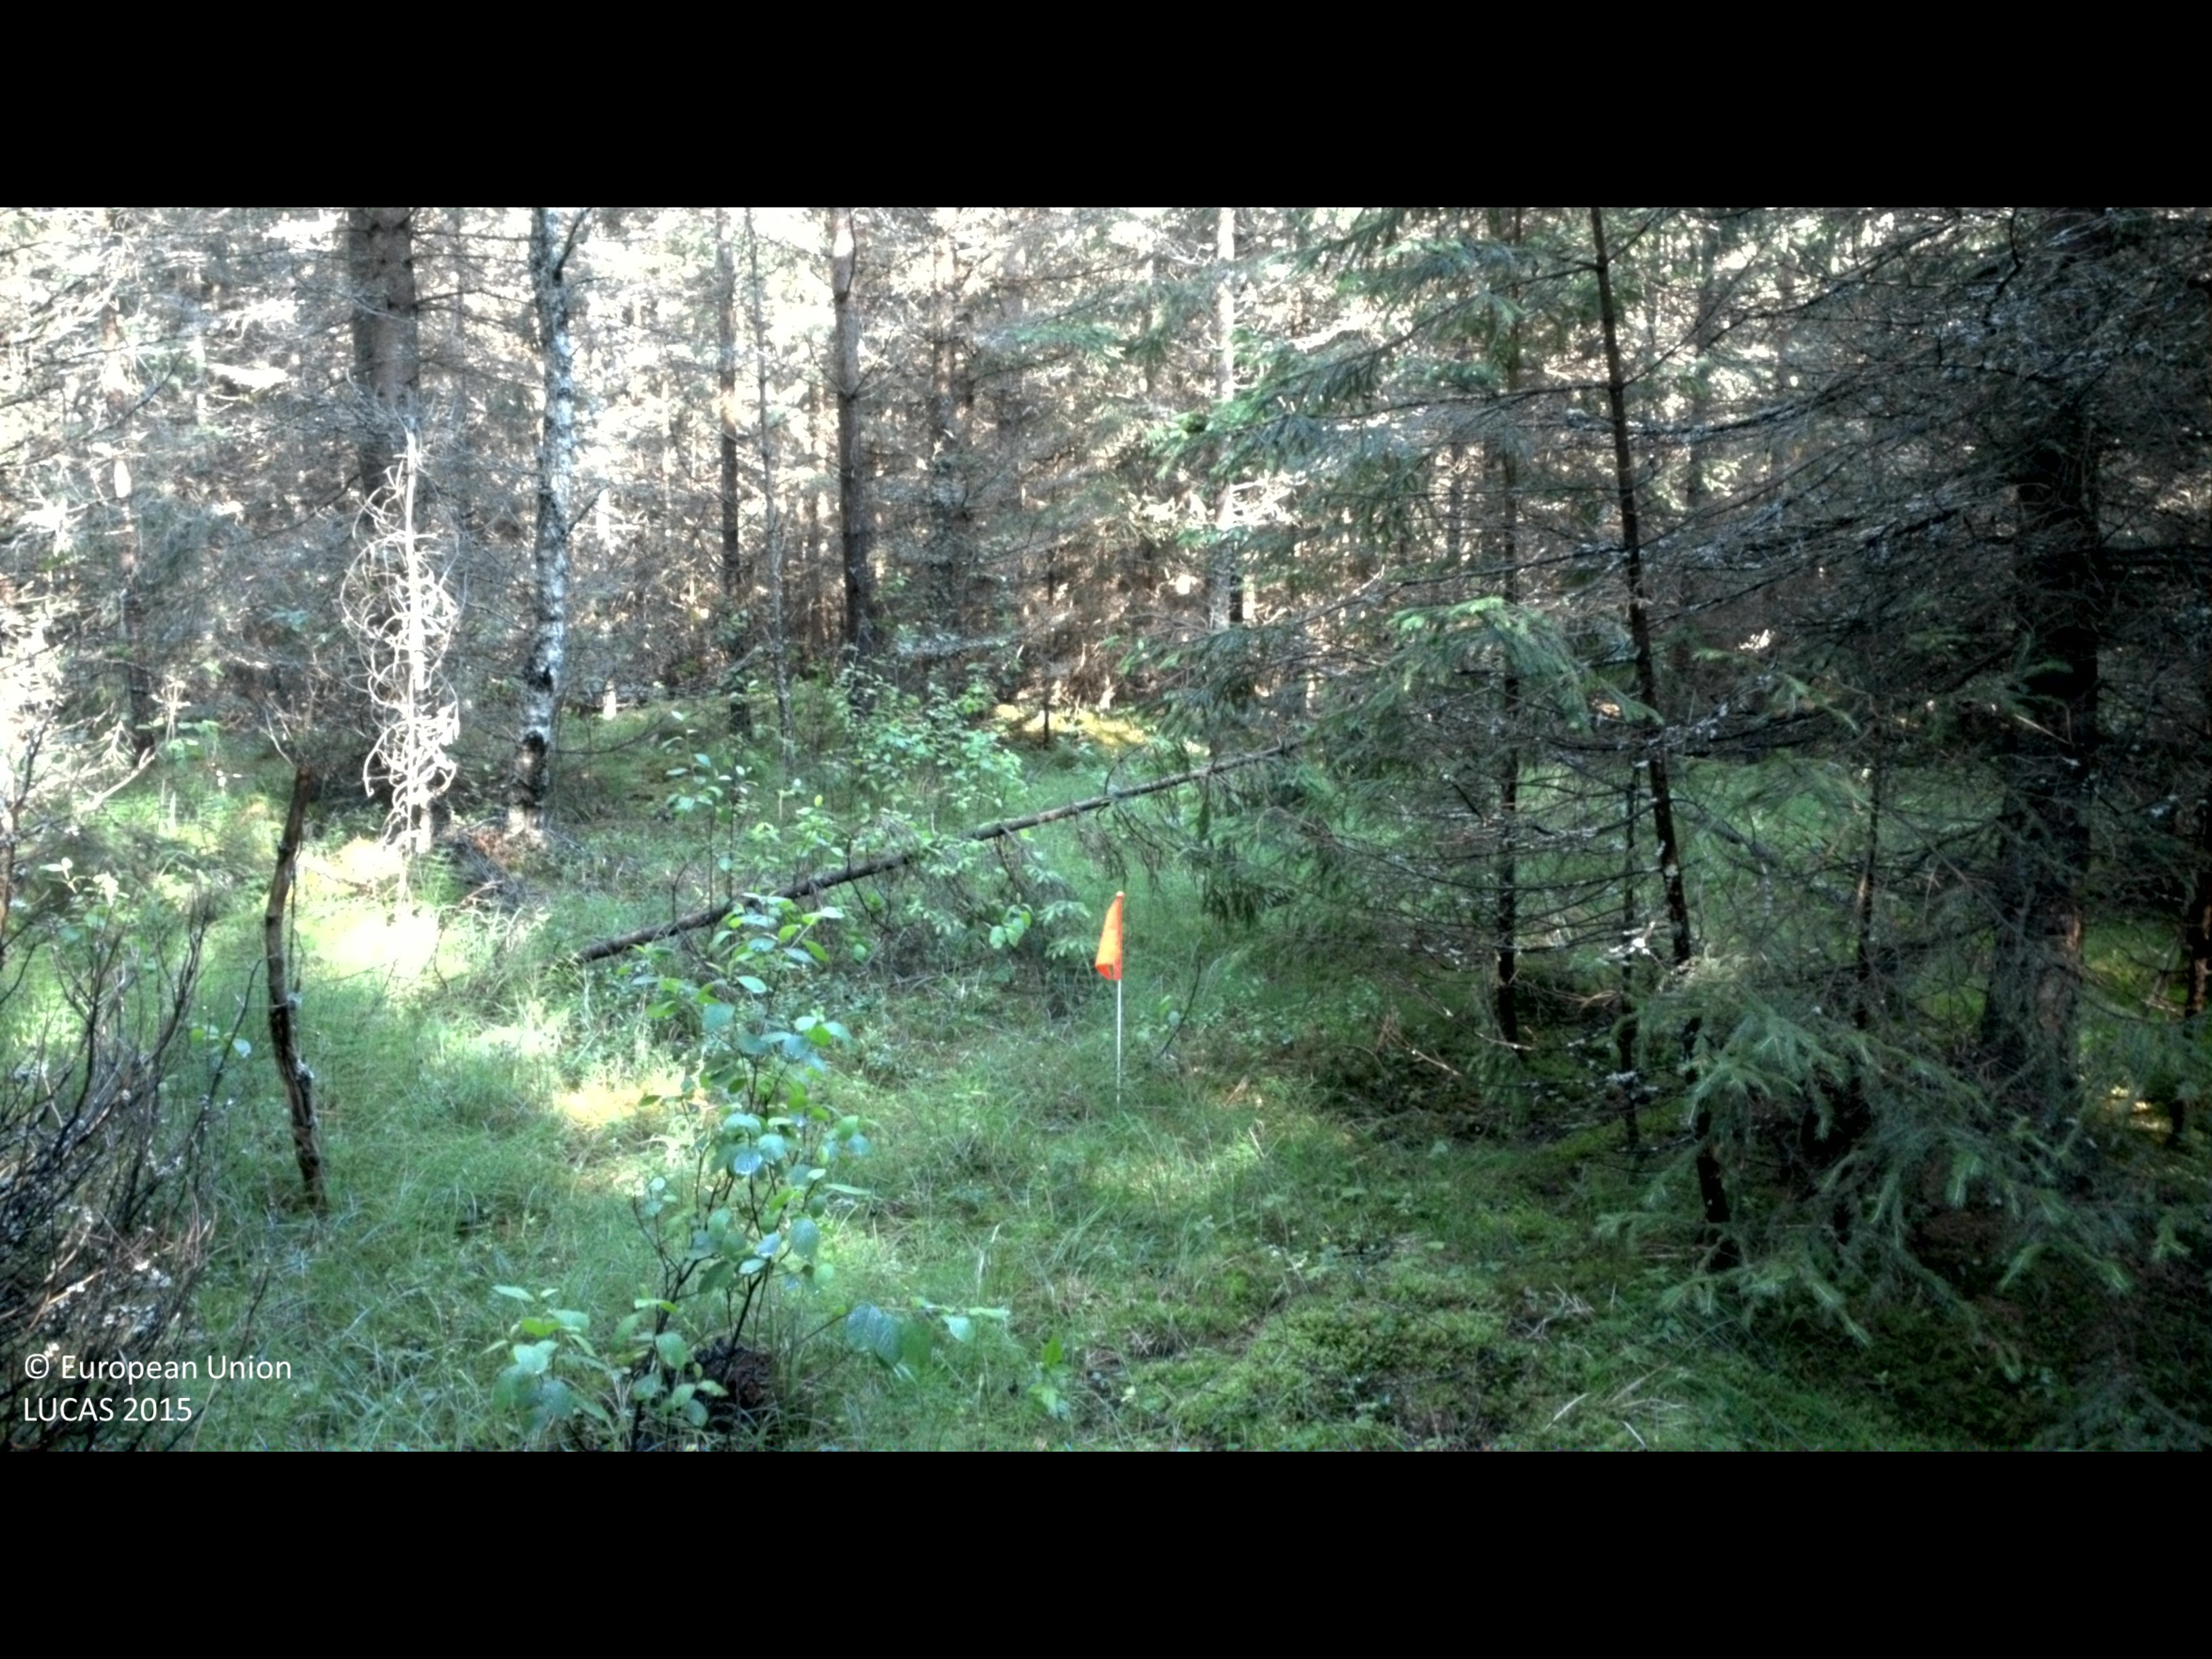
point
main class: Woodland
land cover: Spruce dominated coniferous woodland
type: boreal forest
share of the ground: > 75 %
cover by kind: coniferous forest trees 80 %, broadleaved forest trees 10 %, shrubs 5 %, herbaceous plants 5 %
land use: Forestry
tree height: > 5 m
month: July
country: SE
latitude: 58.4010
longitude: 16.2070
